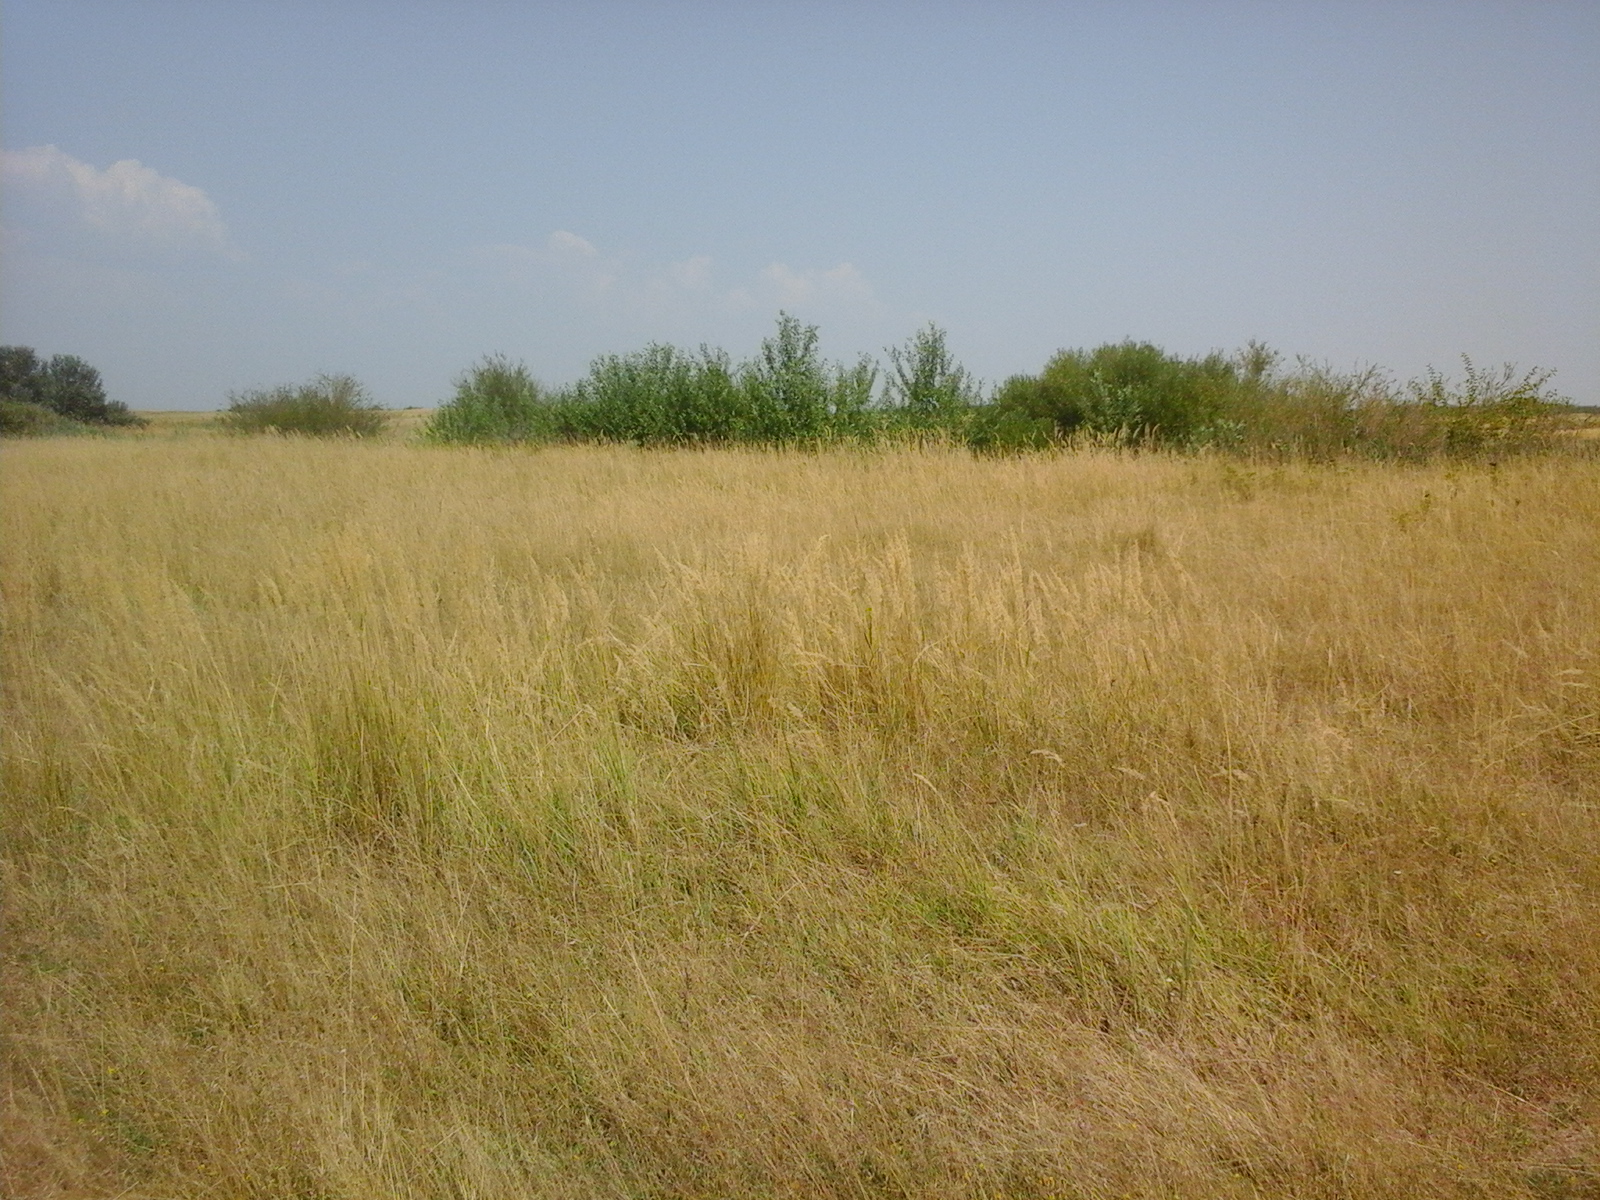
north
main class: Grassland
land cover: Grassland without tree/shrub cover
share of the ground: > 75 %
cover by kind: herbaceous plants 100 %
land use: Agriculture (excluding fallow land and kitchen gardens)
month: August
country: RO
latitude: 44.3604
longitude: 22.6237
